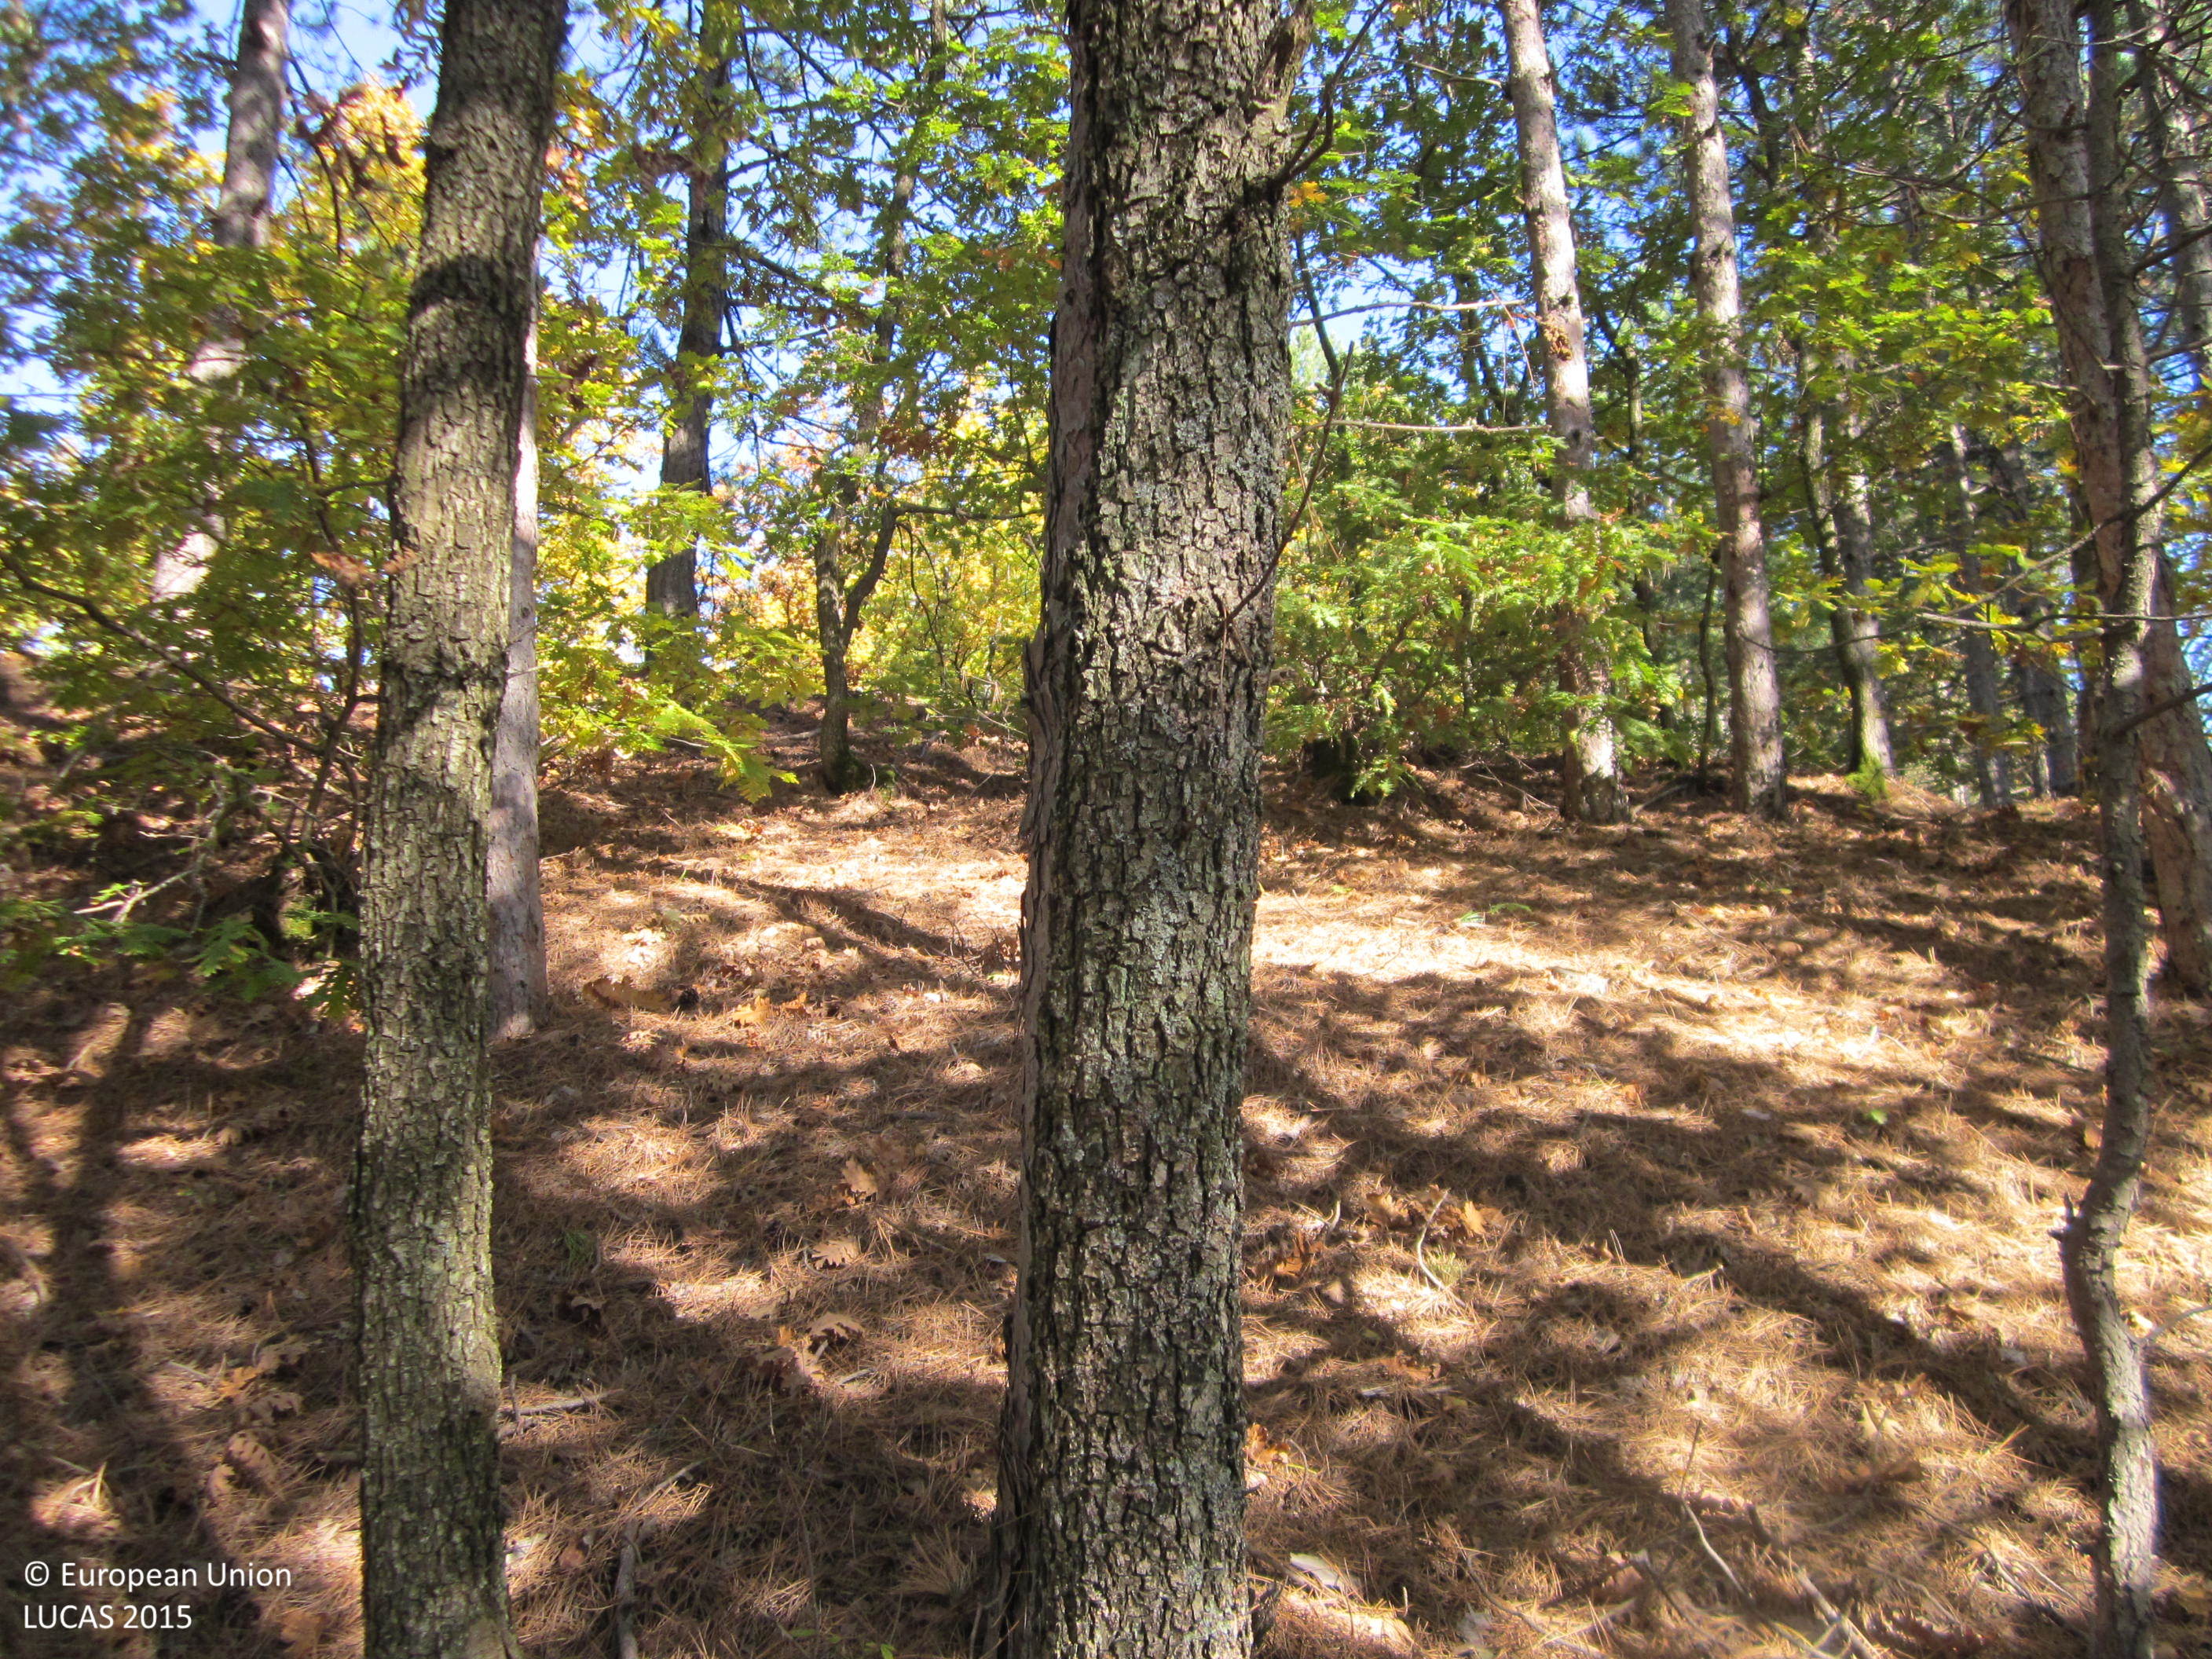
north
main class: Woodland
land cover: Pine dominated coniferous woodland
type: hemiboreal forest and nemoral coniferous forest and mixed broadleaved-coniferous forest
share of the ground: > 75 %
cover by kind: coniferous forest trees 70 %, unconsolidated bare surface 20 %, broadleaved forest trees 10 %
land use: Forestry
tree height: > 5 m
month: November
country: BG
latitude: 41.4664
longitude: 25.7593
